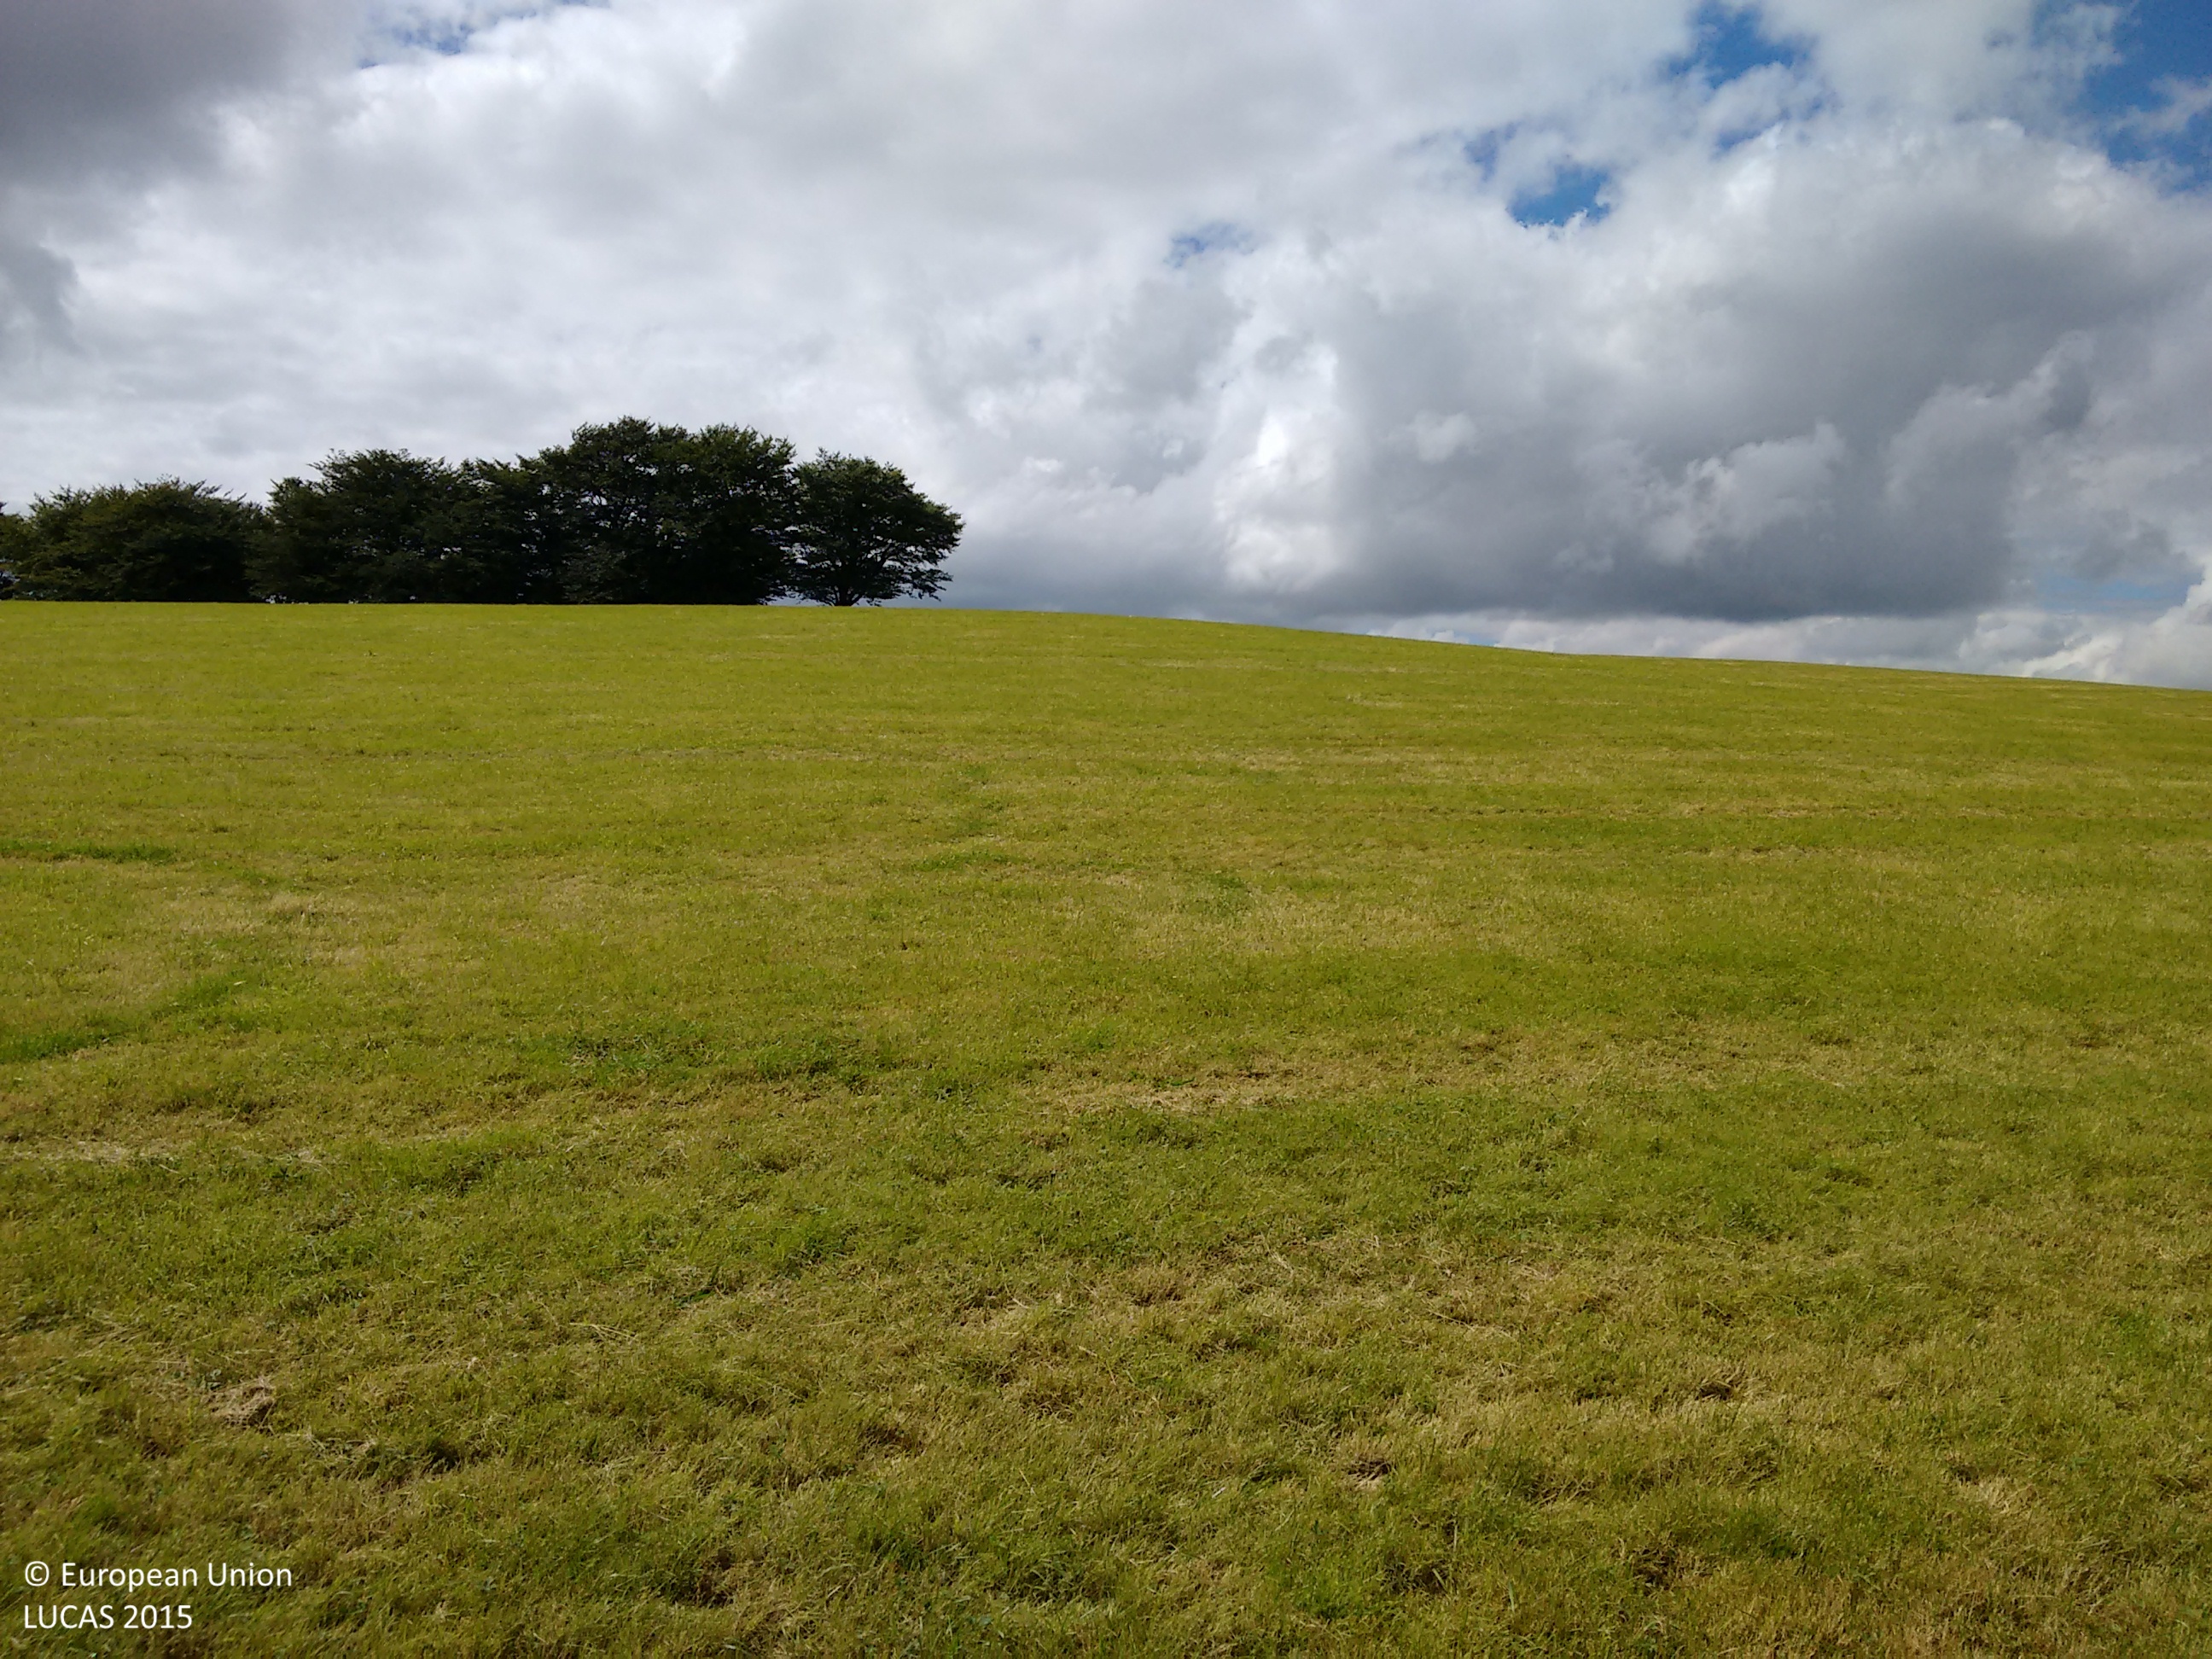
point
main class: Grassland
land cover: Grassland without tree/shrub cover
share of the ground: > 75 %
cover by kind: herbaceous plants 100 %
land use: Agriculture (excluding fallow land and kitchen gardens)
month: August
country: GB
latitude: 52.0055
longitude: -4.0961
